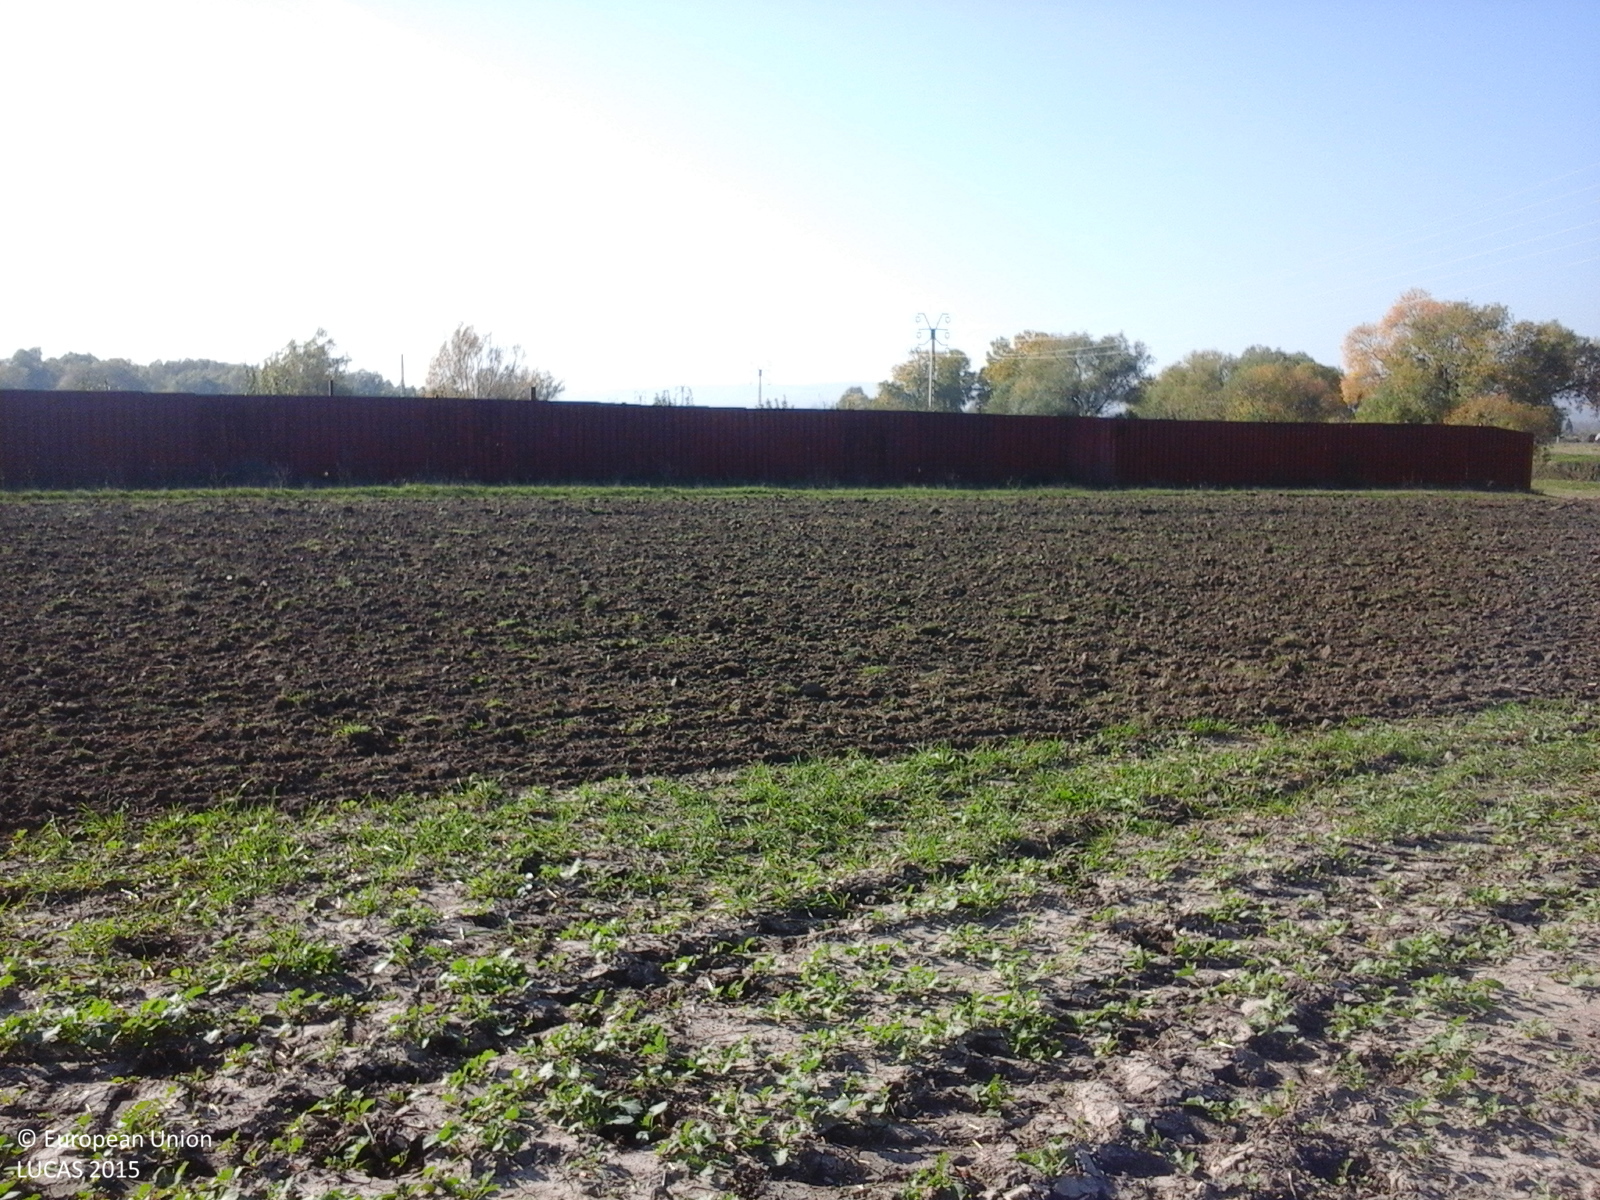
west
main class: Cropland
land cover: Rape and turnip rape
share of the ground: 50 - 75 %
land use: Agriculture (excluding fallow land and kitchen gardens)
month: October
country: RO
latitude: 45.6739
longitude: 27.1280
